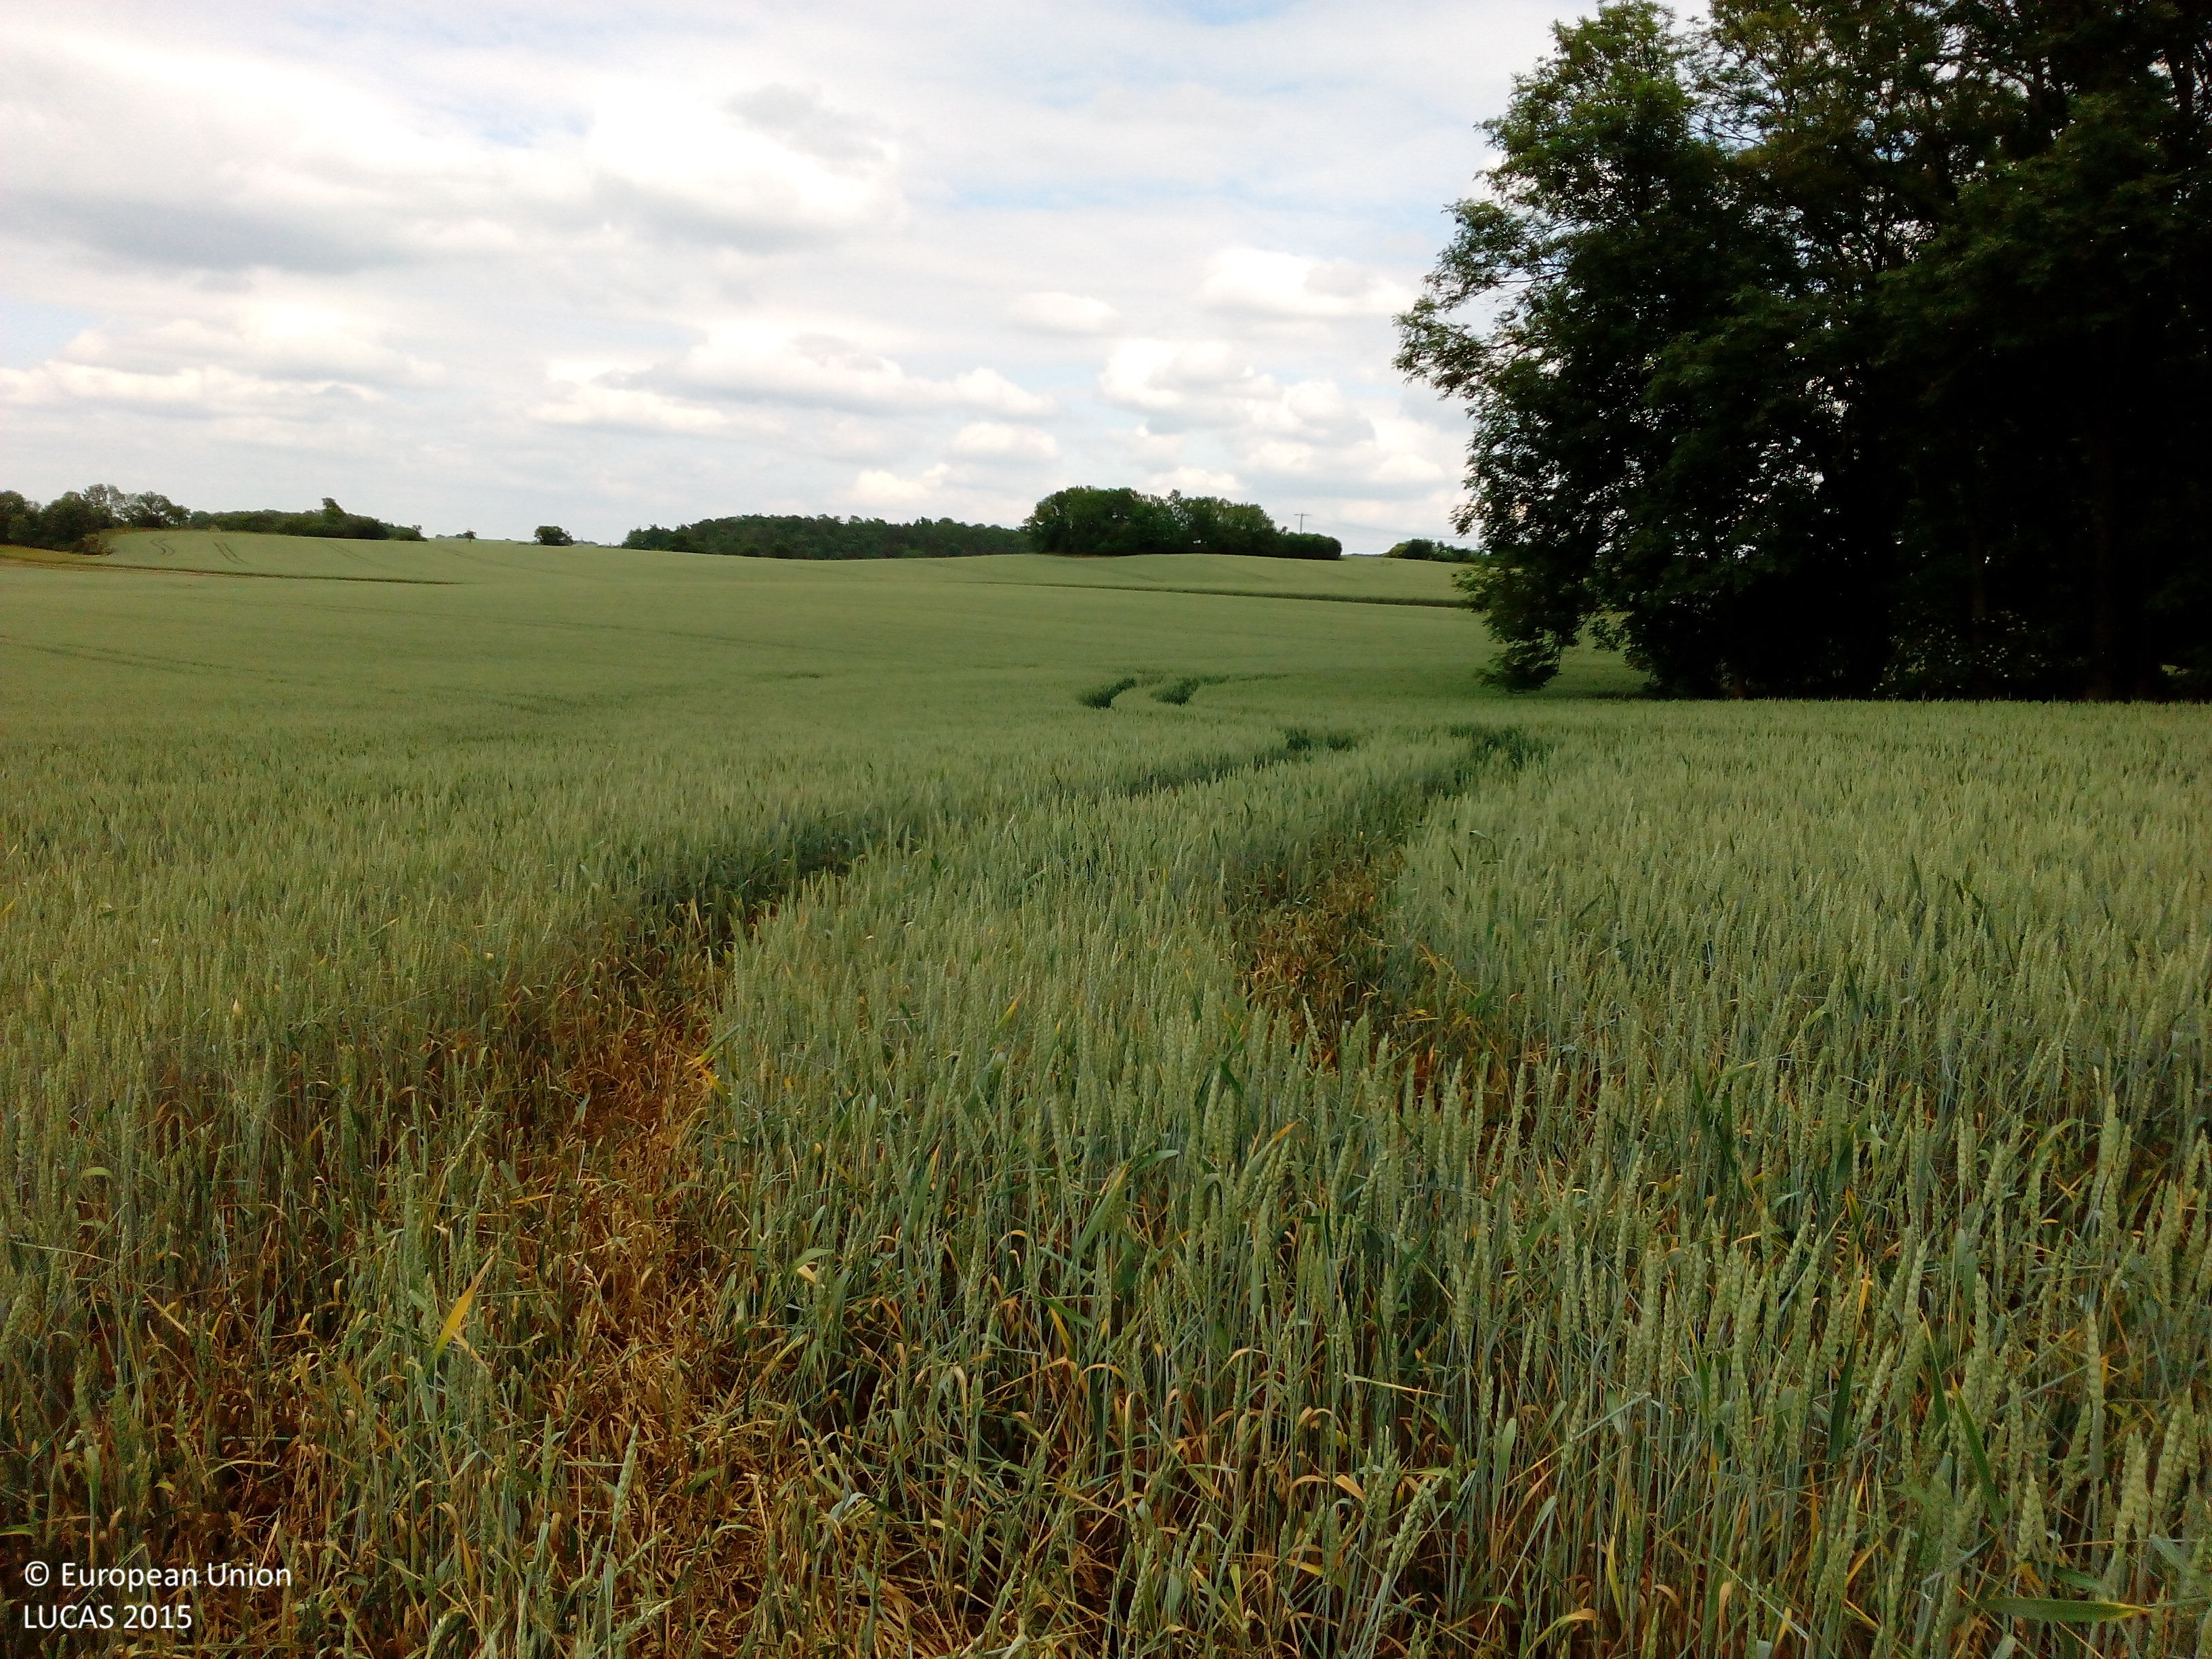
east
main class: Cropland
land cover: Common wheat
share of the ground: > 75 %
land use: Agriculture (excluding fallow land and kitchen gardens)
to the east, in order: Common wheat
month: June
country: DE
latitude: 50.6938
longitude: 11.6559
